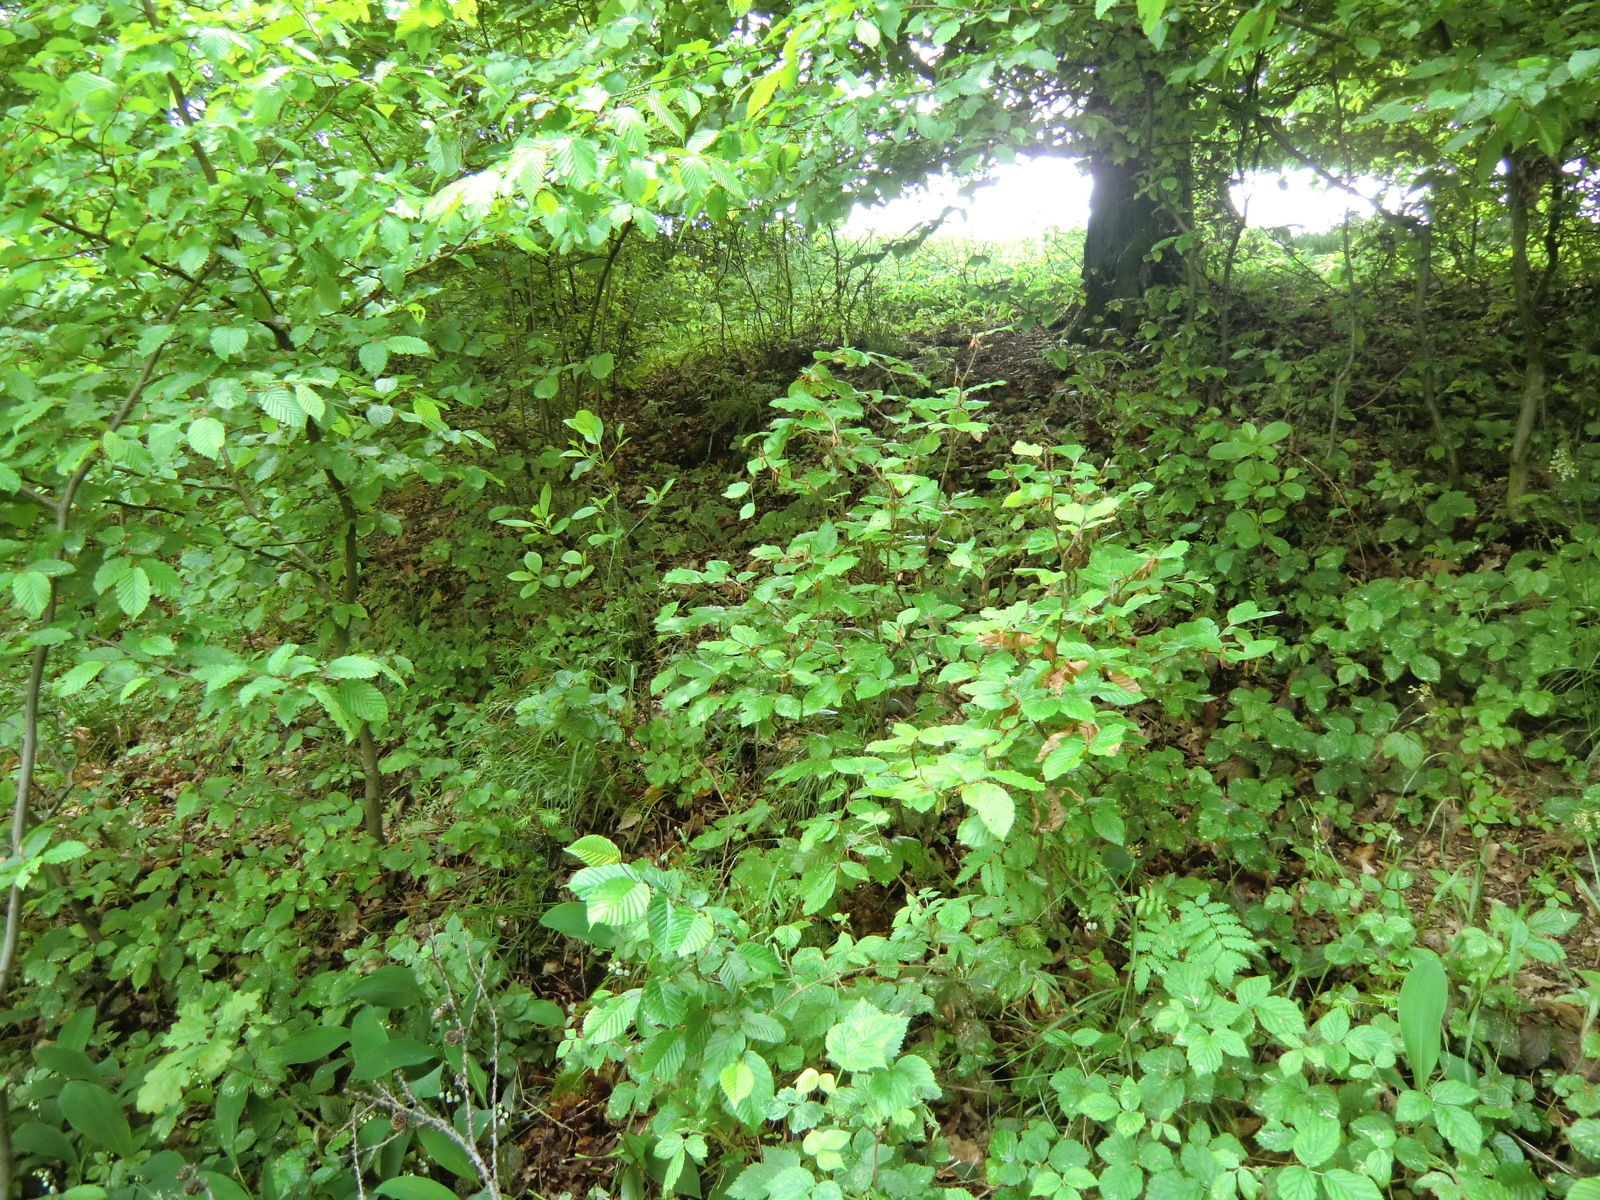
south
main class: Woodland
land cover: Spruce dominated mixed woodland
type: mountainous beech forest
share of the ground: > 75 %
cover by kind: broadleaved forest trees 30 %, shrubs 30 %, coniferous forest trees 20 %, herbaceous plants 10 %, unconsolidated bare surface 10 %
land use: Forestry
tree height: > 5 m
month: May
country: AT
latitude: 48.2709
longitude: 14.6219
